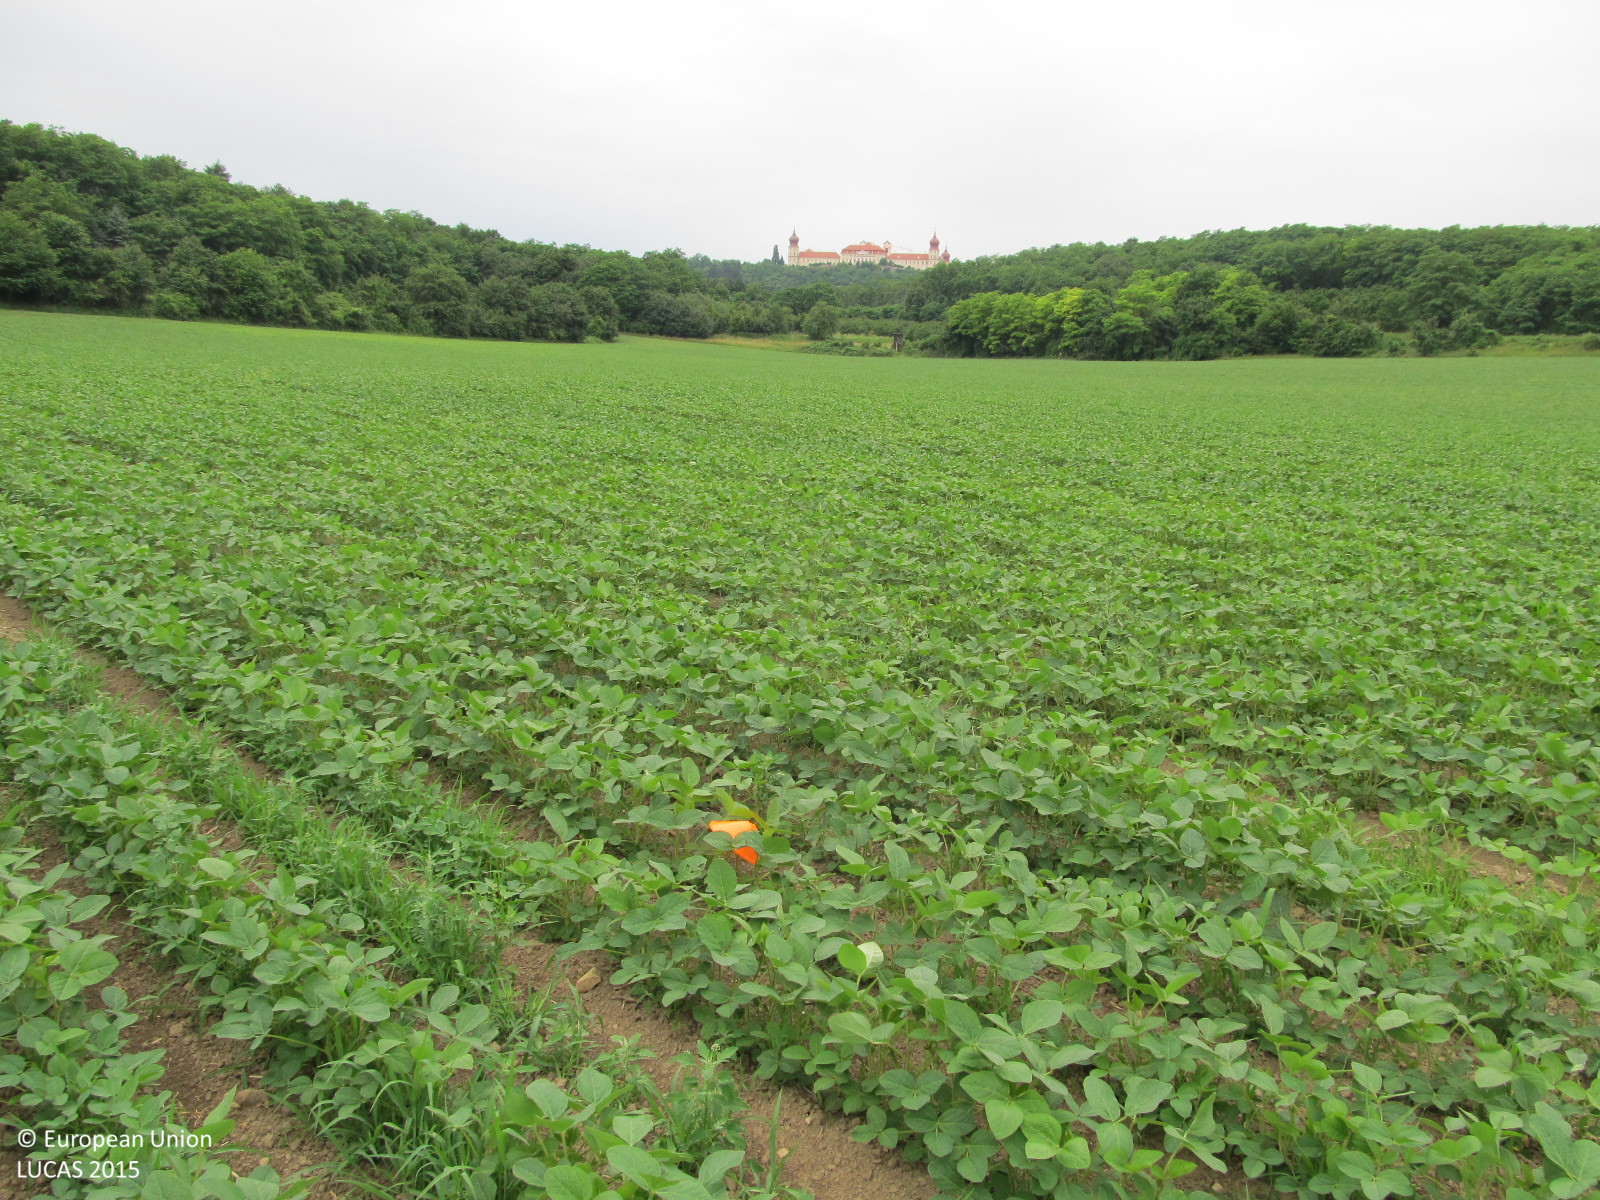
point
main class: Cropland
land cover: Soya
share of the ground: 50 - 75 %
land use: Agriculture (excluding fallow land and kitchen gardens)
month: June
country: AT
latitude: 48.3682
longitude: 15.6319
